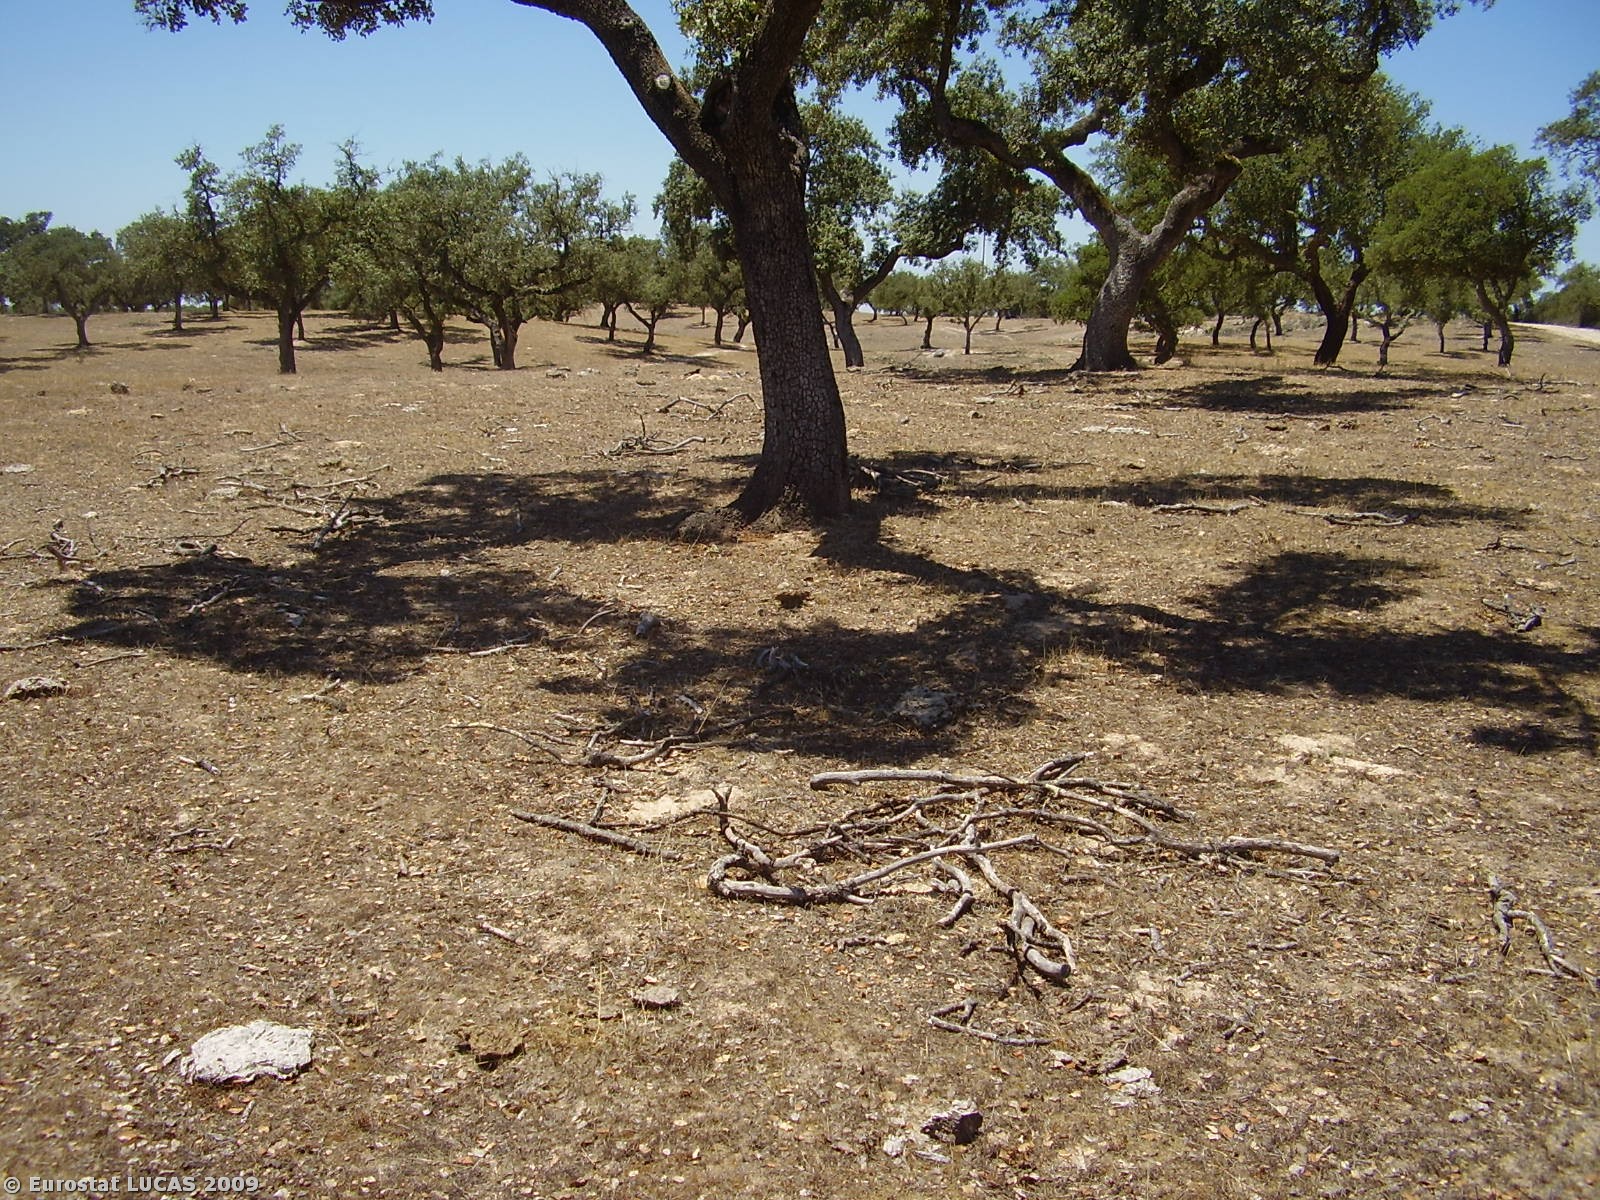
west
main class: Woodland
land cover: Broadleaved woodland
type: broadleaved evergreen forest
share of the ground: 10 - 25 %
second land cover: Grassland with sparse tree/shrub cover
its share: 50 - 75 %
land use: Forestry
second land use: Fallow land
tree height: > 5 m
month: July
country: PT
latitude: 38.8477
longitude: -7.8920
